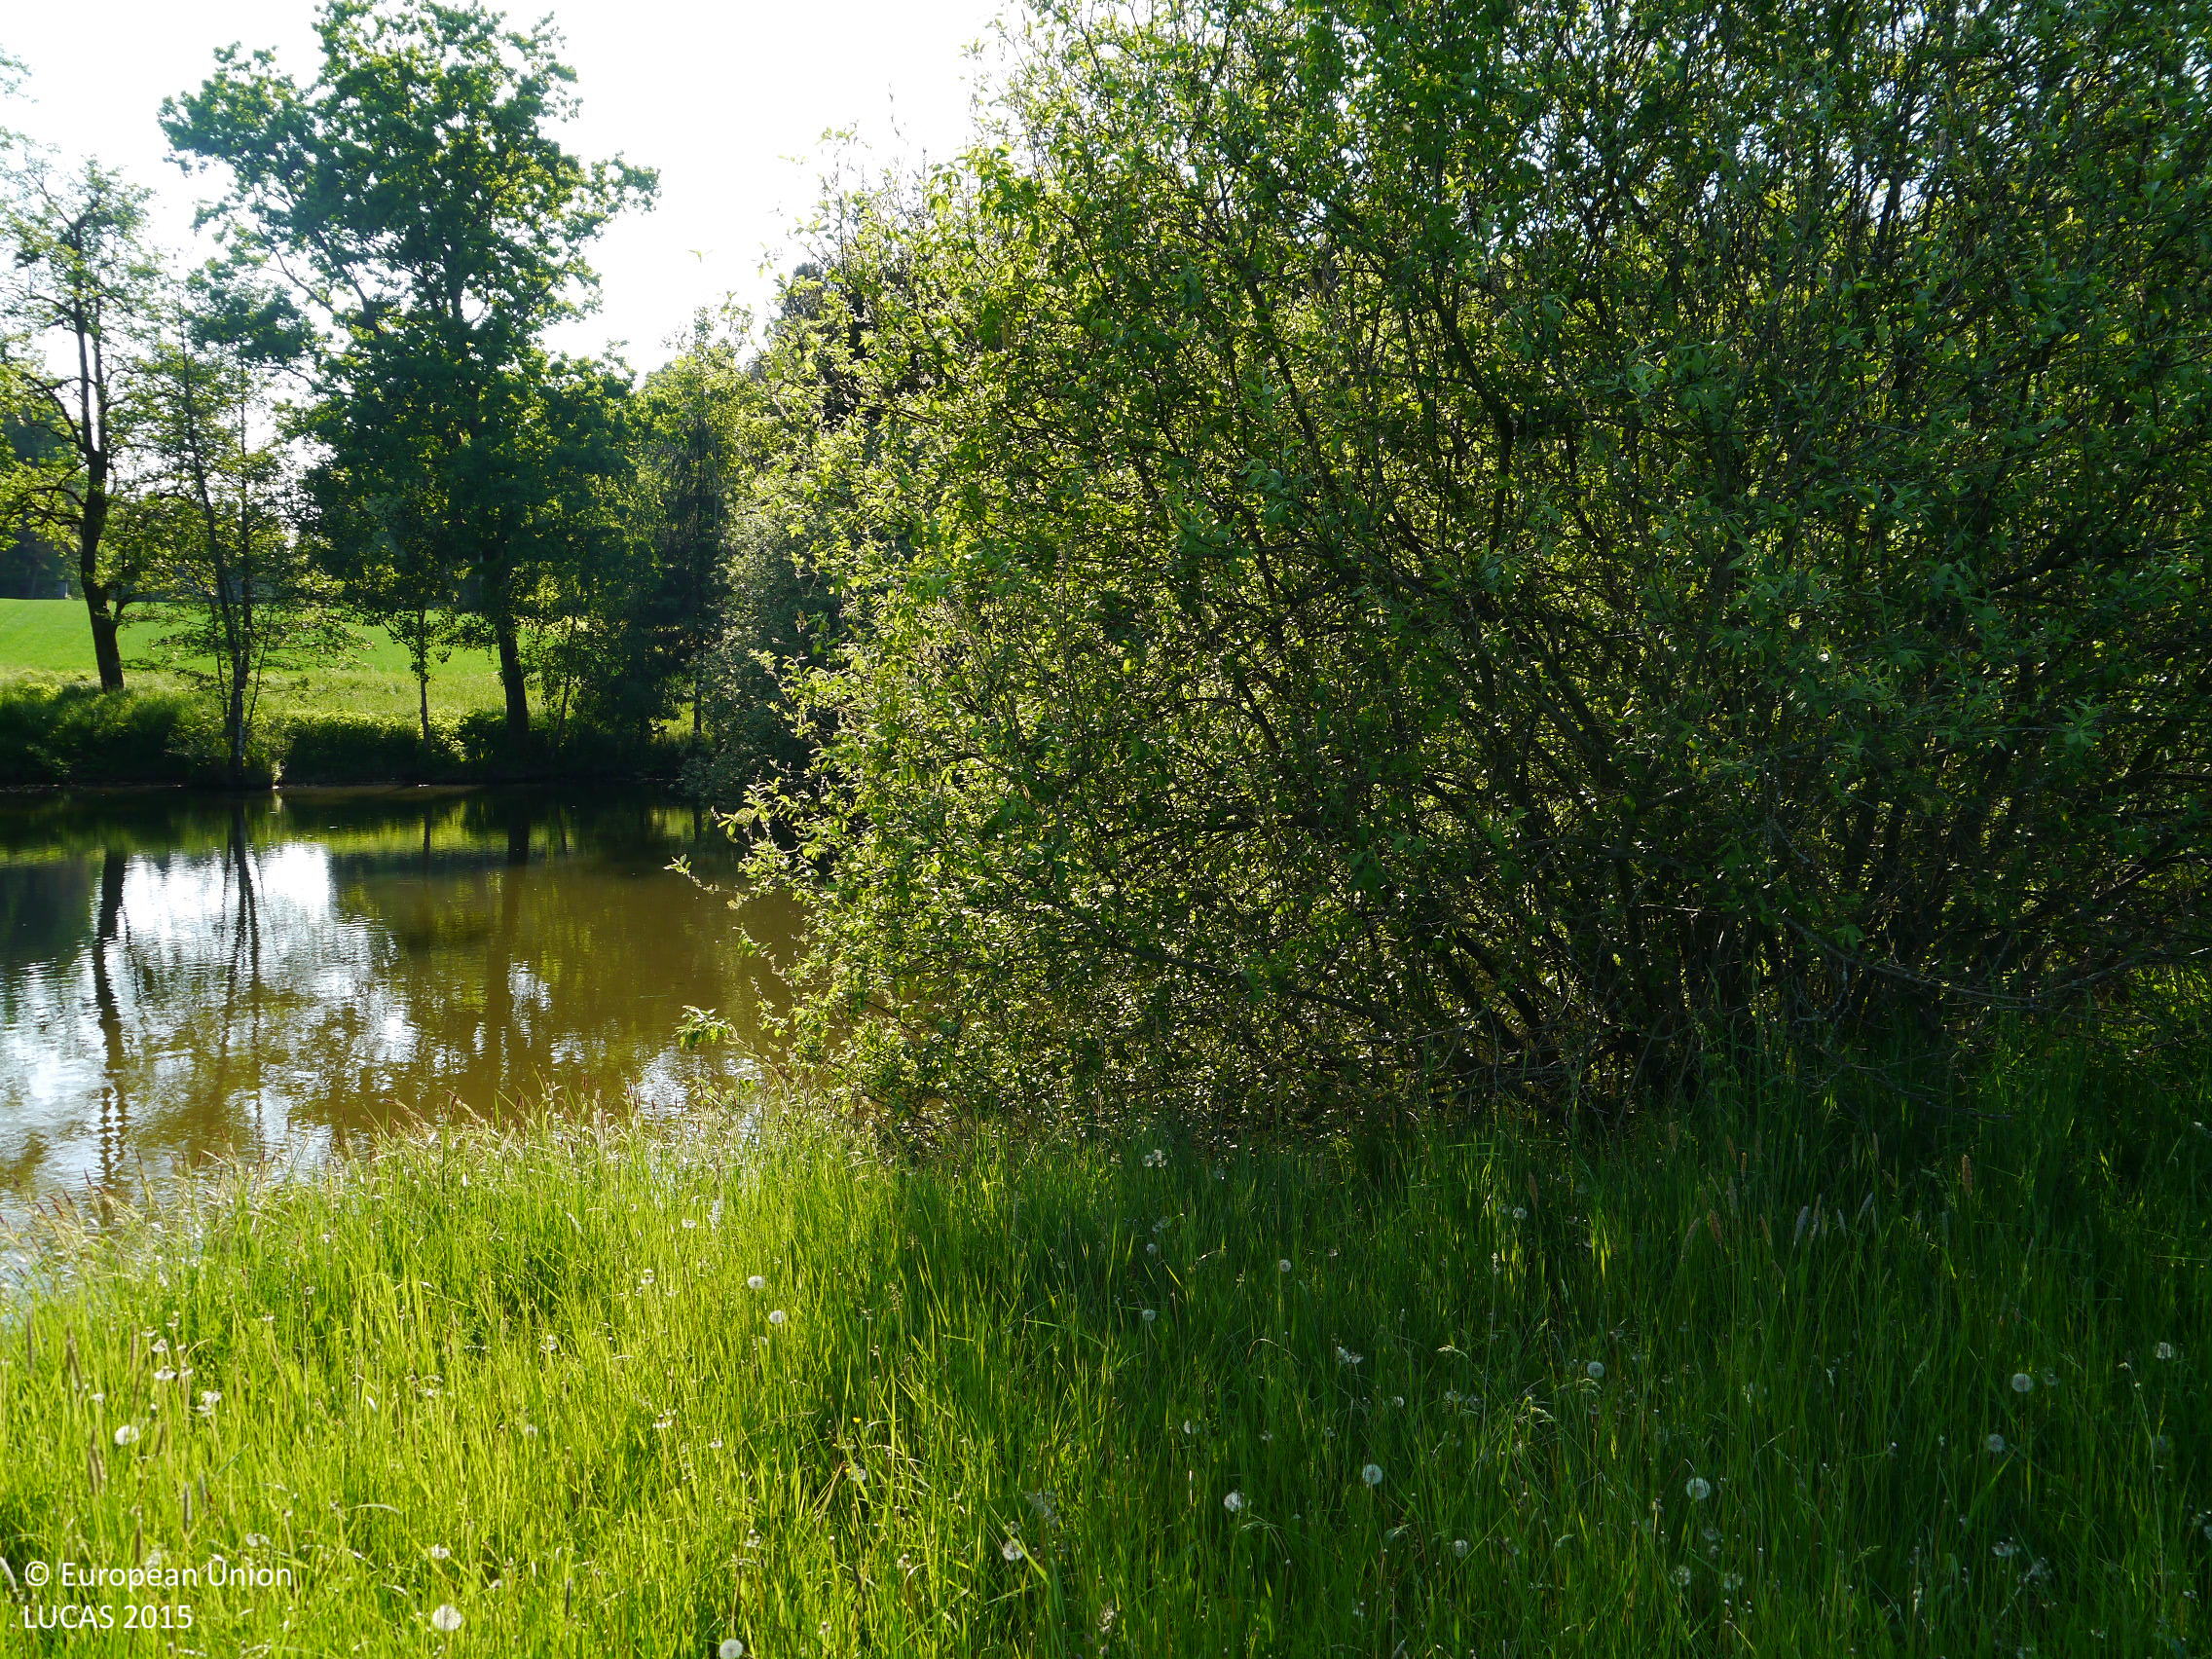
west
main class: Cropland
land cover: Common wheat
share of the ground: > 75 %
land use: Agriculture (excluding fallow land and kitchen gardens)
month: May
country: AT
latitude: 46.9548
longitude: 15.4001
